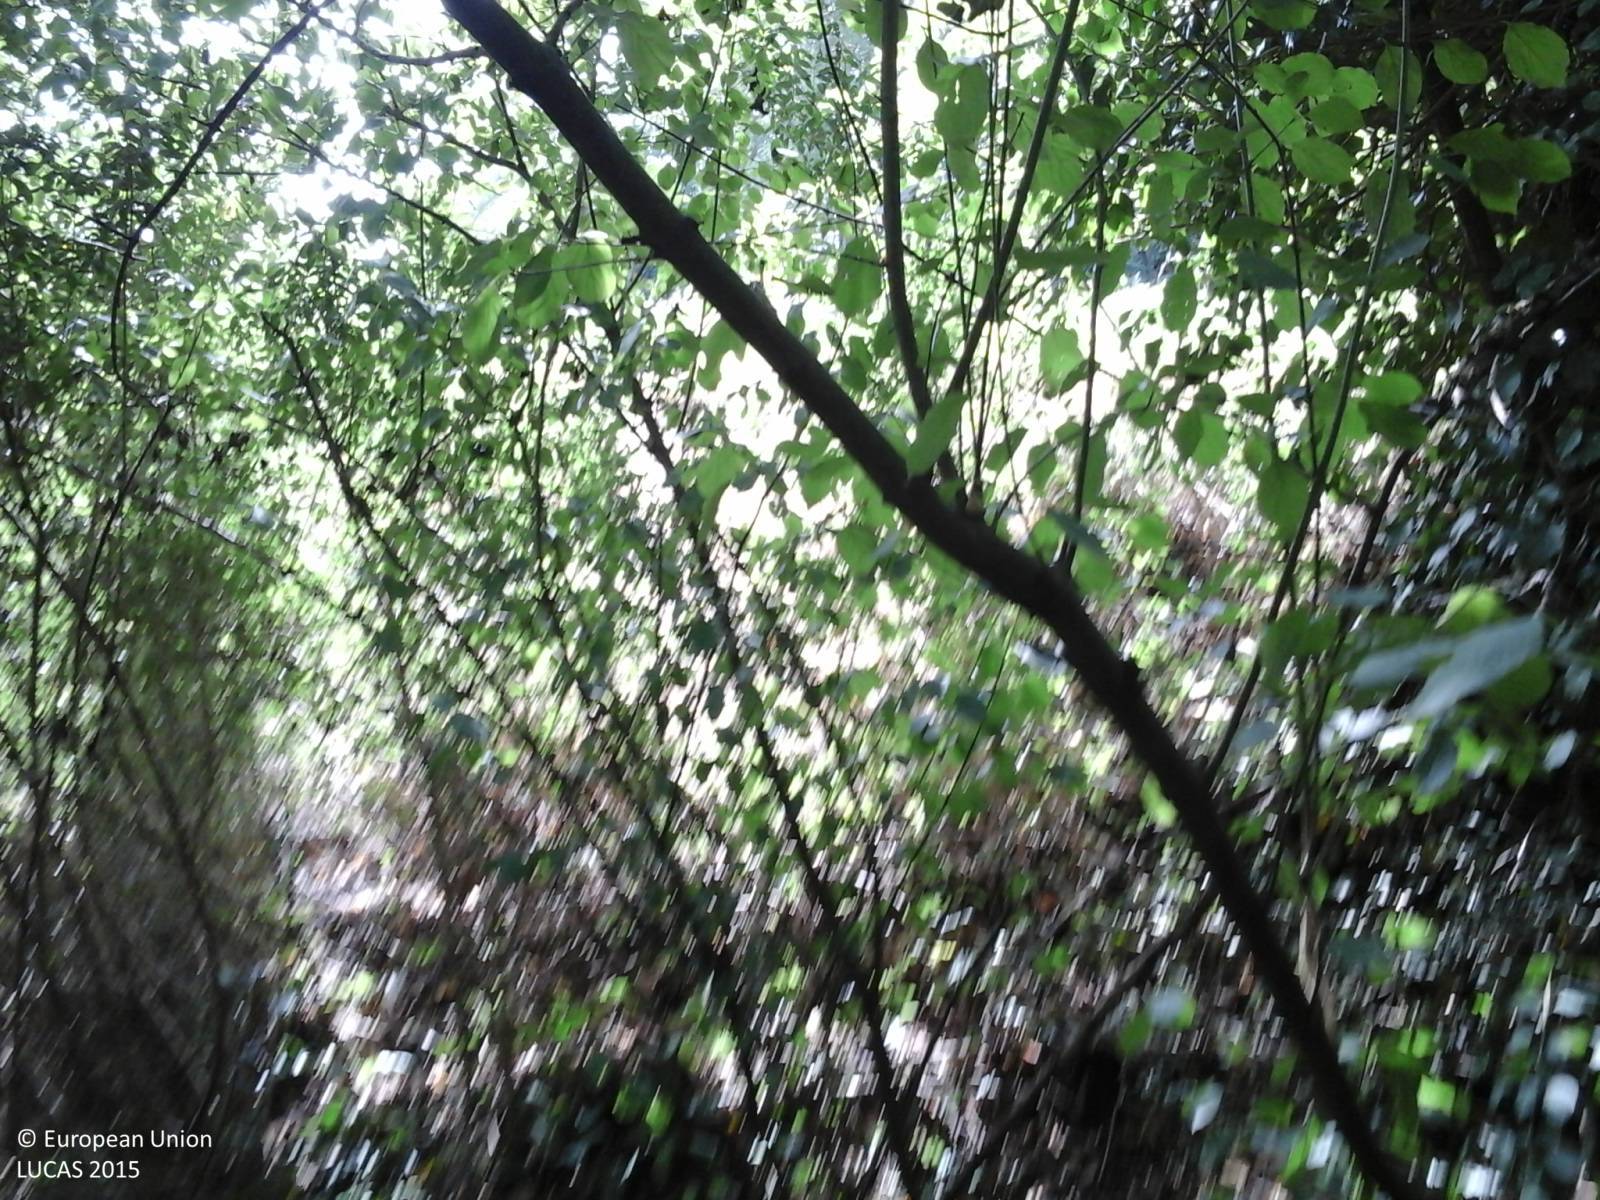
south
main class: Woodland
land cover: Broadleaved woodland
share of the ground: > 75 %
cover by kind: broadleaved forest trees 80 %, shrubs 20 %
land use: Forestry
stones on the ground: < 10 %
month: September
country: IT
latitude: 42.9757
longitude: 12.0905
